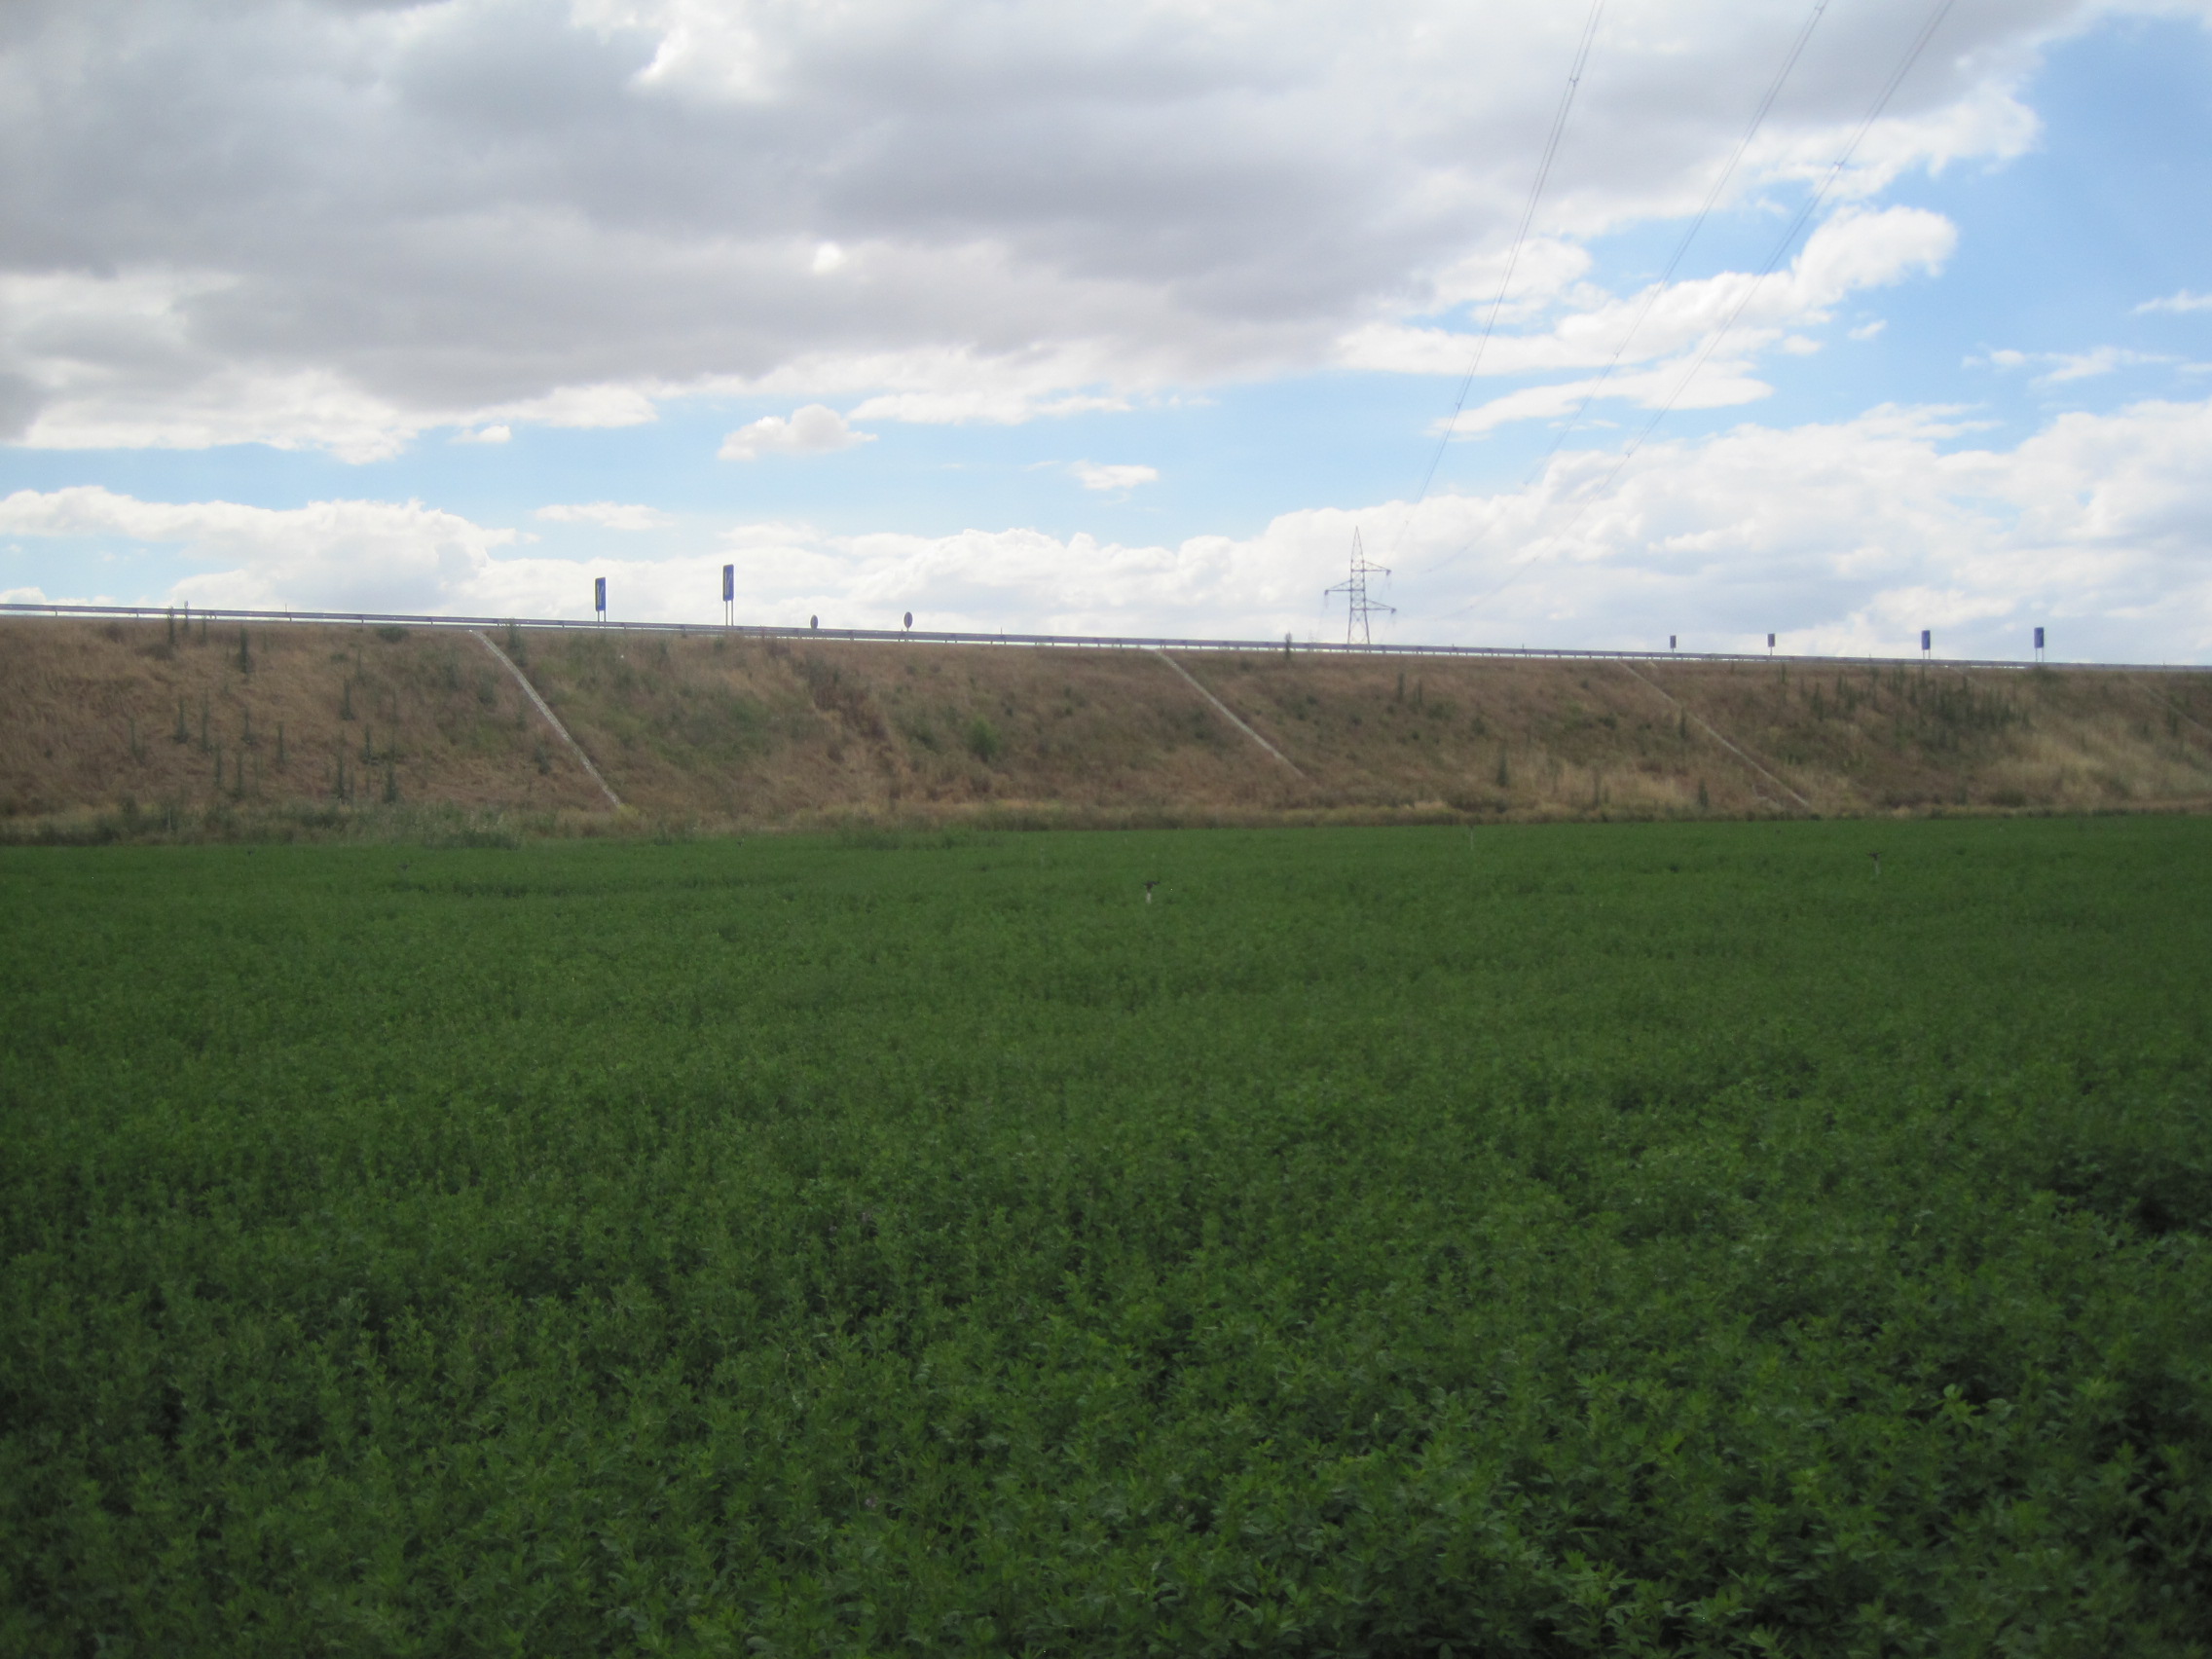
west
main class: Cropland
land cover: Lucerne
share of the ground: > 75 %
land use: Agriculture (excluding fallow land and kitchen gardens)
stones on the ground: 10 - 25 %
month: June
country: ES
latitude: 41.7251
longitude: -4.6749
